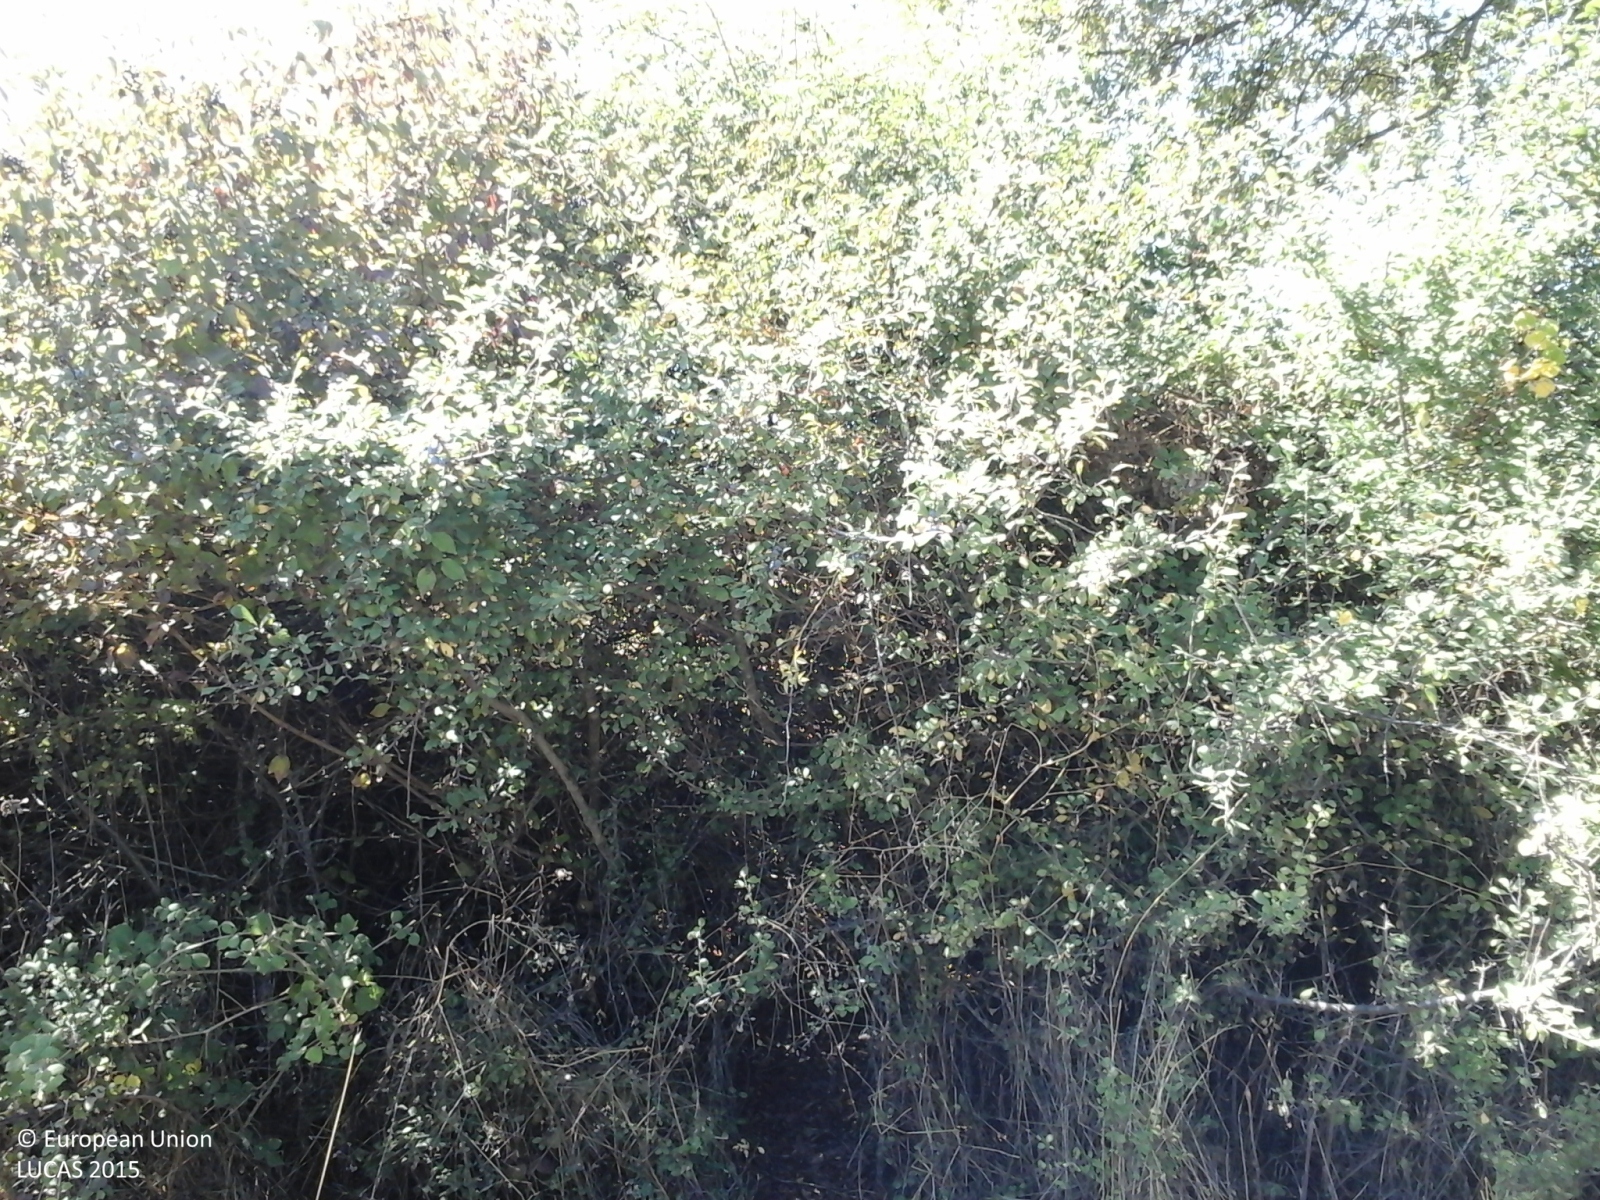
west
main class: Woodland
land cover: Broadleaved woodland
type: thermophilous deciduous forest
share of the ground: 50 - 75 %
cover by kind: broadleaved forest trees 70 %, shrubs 30 %
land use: Semi-natural and natural areas not in use
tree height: > 5 m
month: September
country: GR
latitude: 40.3930
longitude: 21.3344
